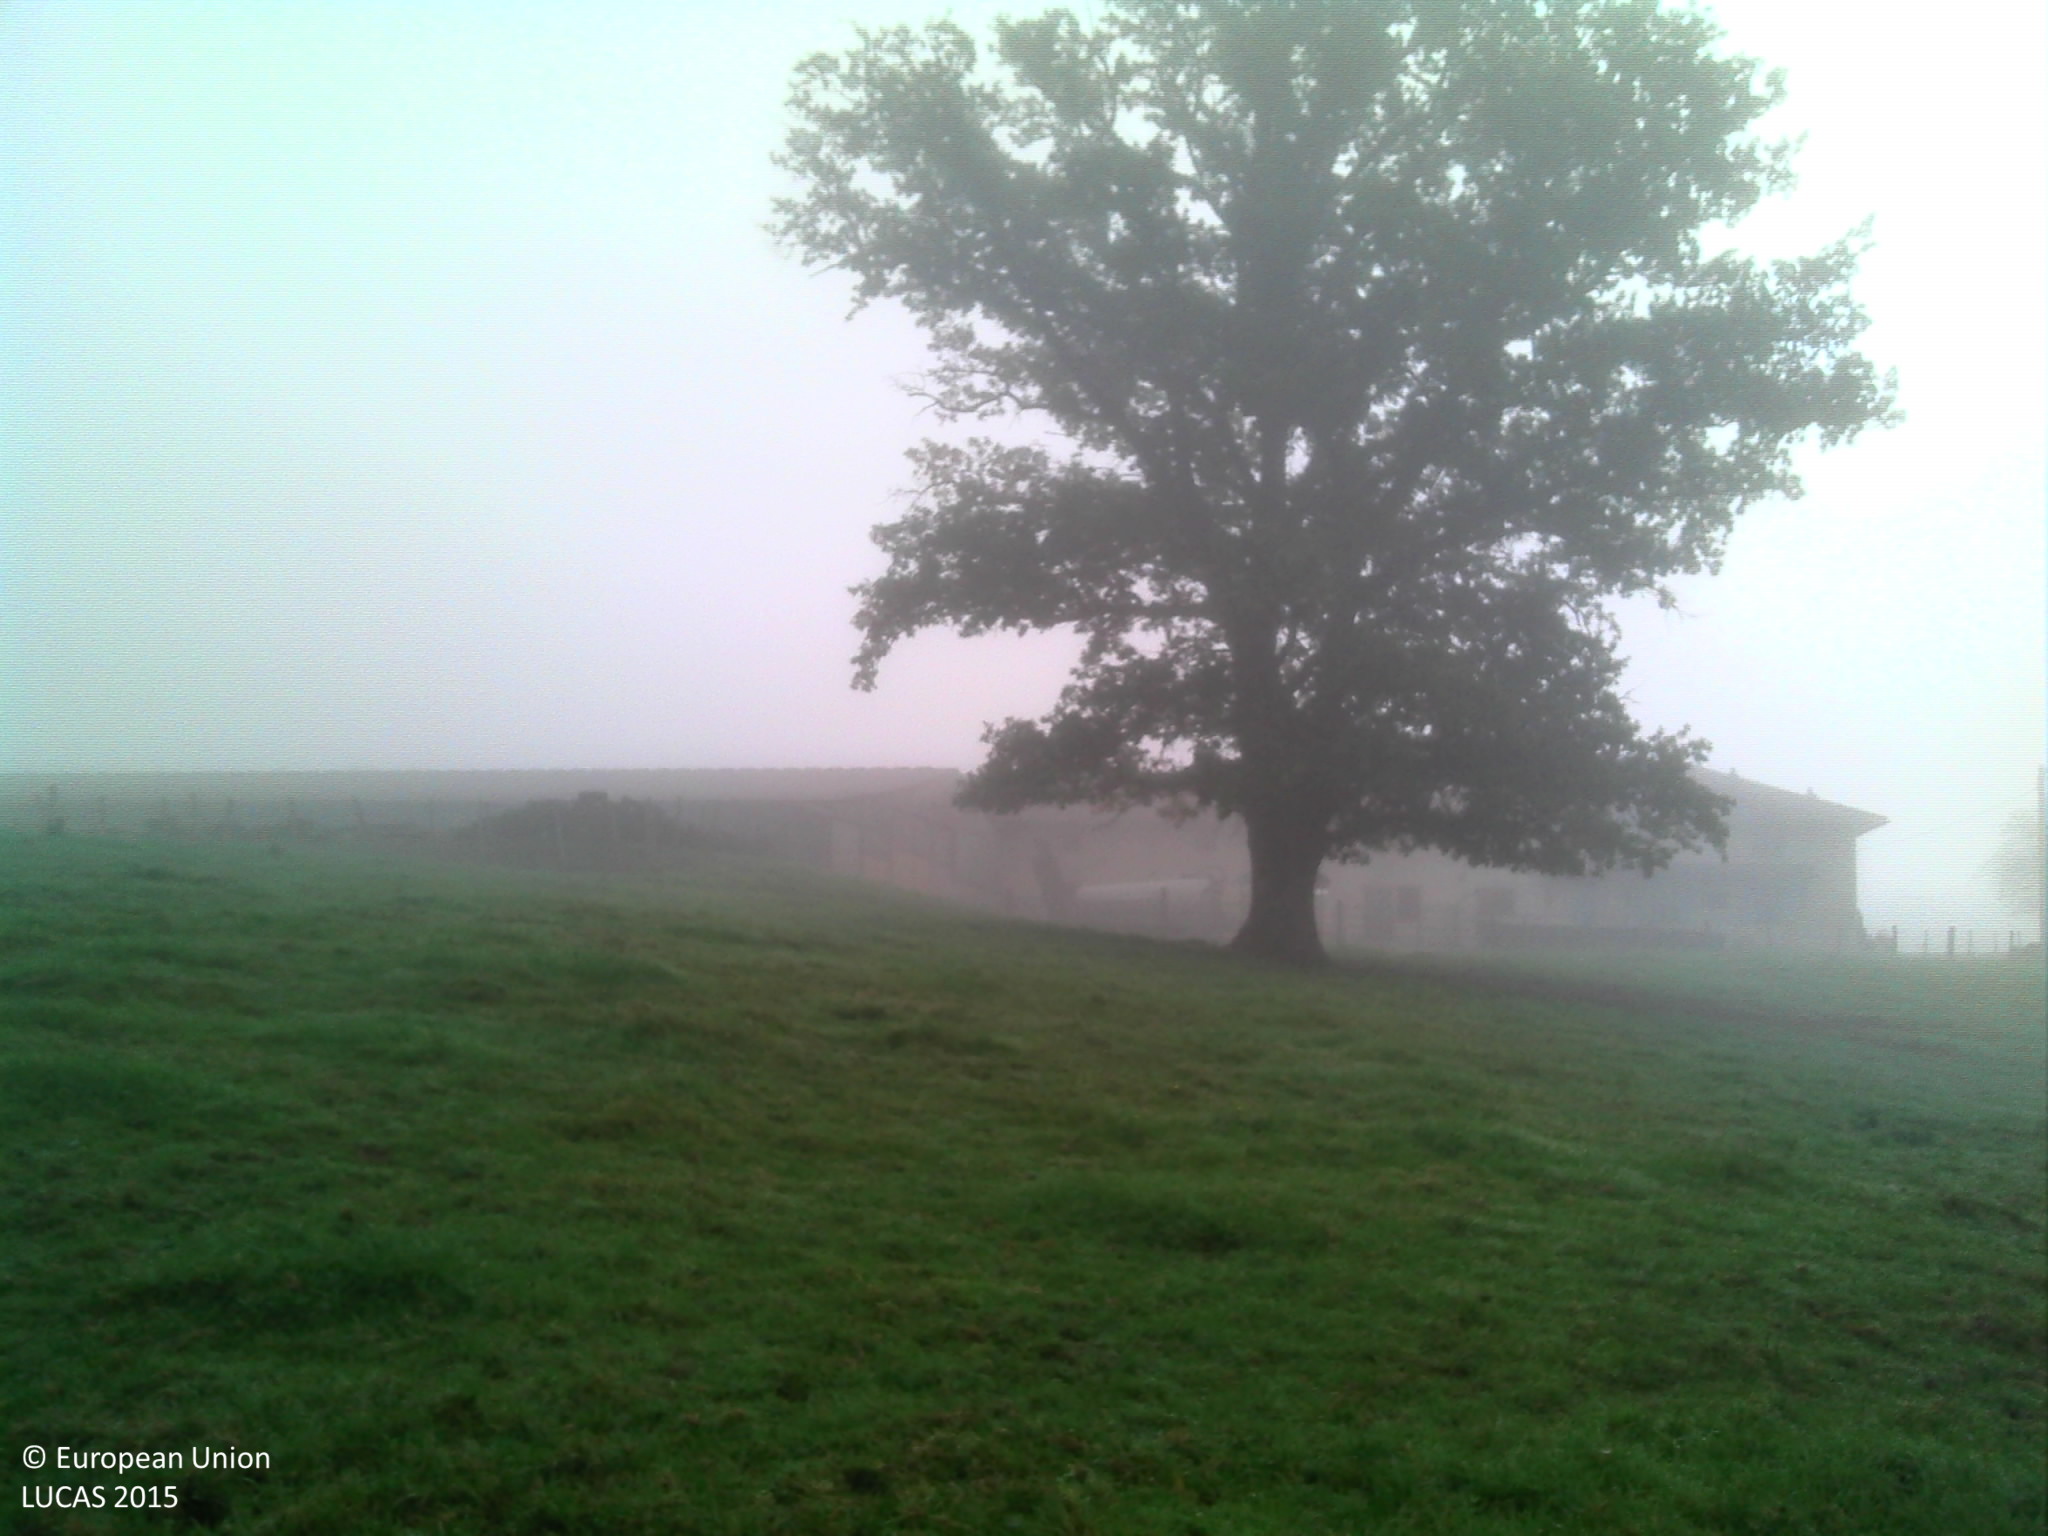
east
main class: Grassland
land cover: Grassland without tree/shrub cover
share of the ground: > 75 %
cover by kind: herbaceous plants 100 %
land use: Agriculture (excluding fallow land and kitchen gardens)
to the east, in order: Grassland without tree/shrub cover; Artificial constructions in urban areas; Grassland without tree/shrub cover
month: October
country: FR
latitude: 46.3376
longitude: 5.2868
